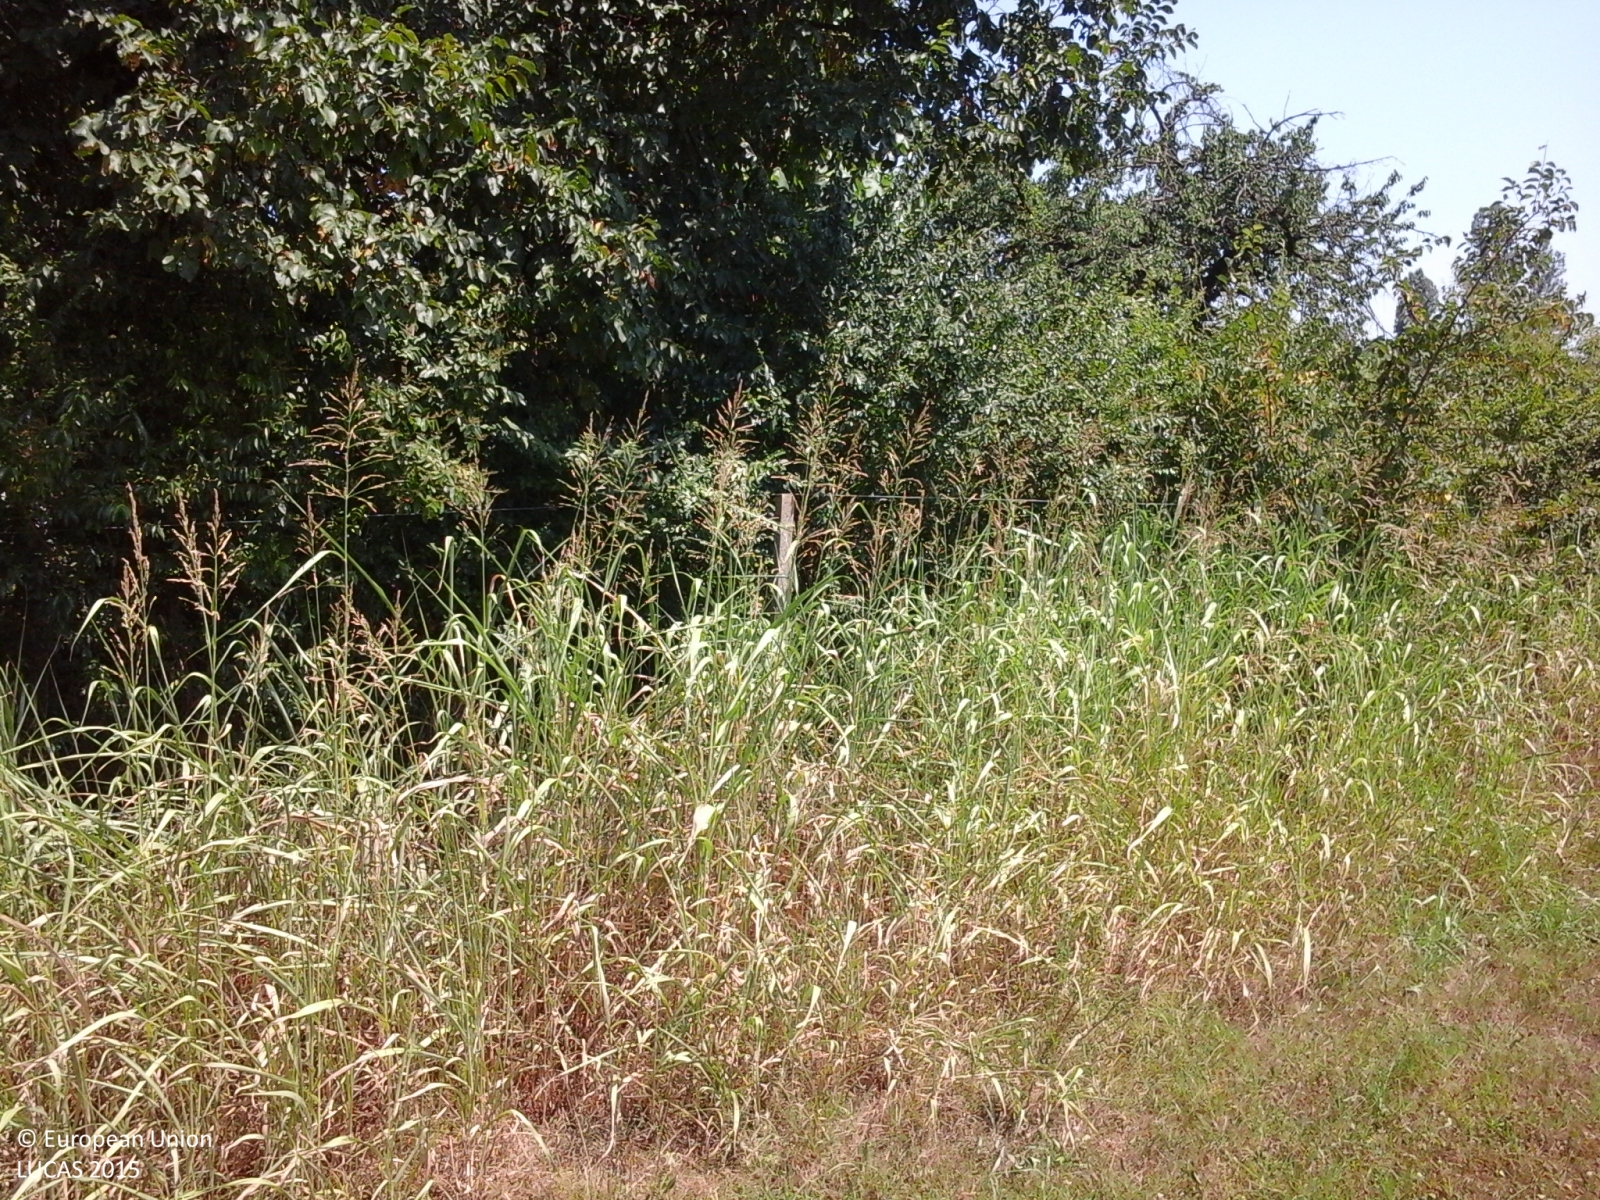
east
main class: Grassland
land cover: Grassland without tree/shrub cover
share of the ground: > 75 %
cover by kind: herbaceous plants 100 %
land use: Agriculture (excluding fallow land and kitchen gardens)
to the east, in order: Grassland without tree/shrub cover; Artificial constructions in urban areas; Managed hedges; Electric lines; Grassland without tree/shrub cover; Abandoned hedges; Ditches and canals; Abandoned hedges; Spontaneously vegetated surfaces; Broadleaved woodland; Ditches and canals; Electric lines; Abandoned hedges; Grassland without tree/shrub cover; Vineyards; Grassland without tree/shrub cover; Fences; Managed hedges; Paved roads, cycling and walking lanes
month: July
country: IT
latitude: 45.7318
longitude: 12.2969
